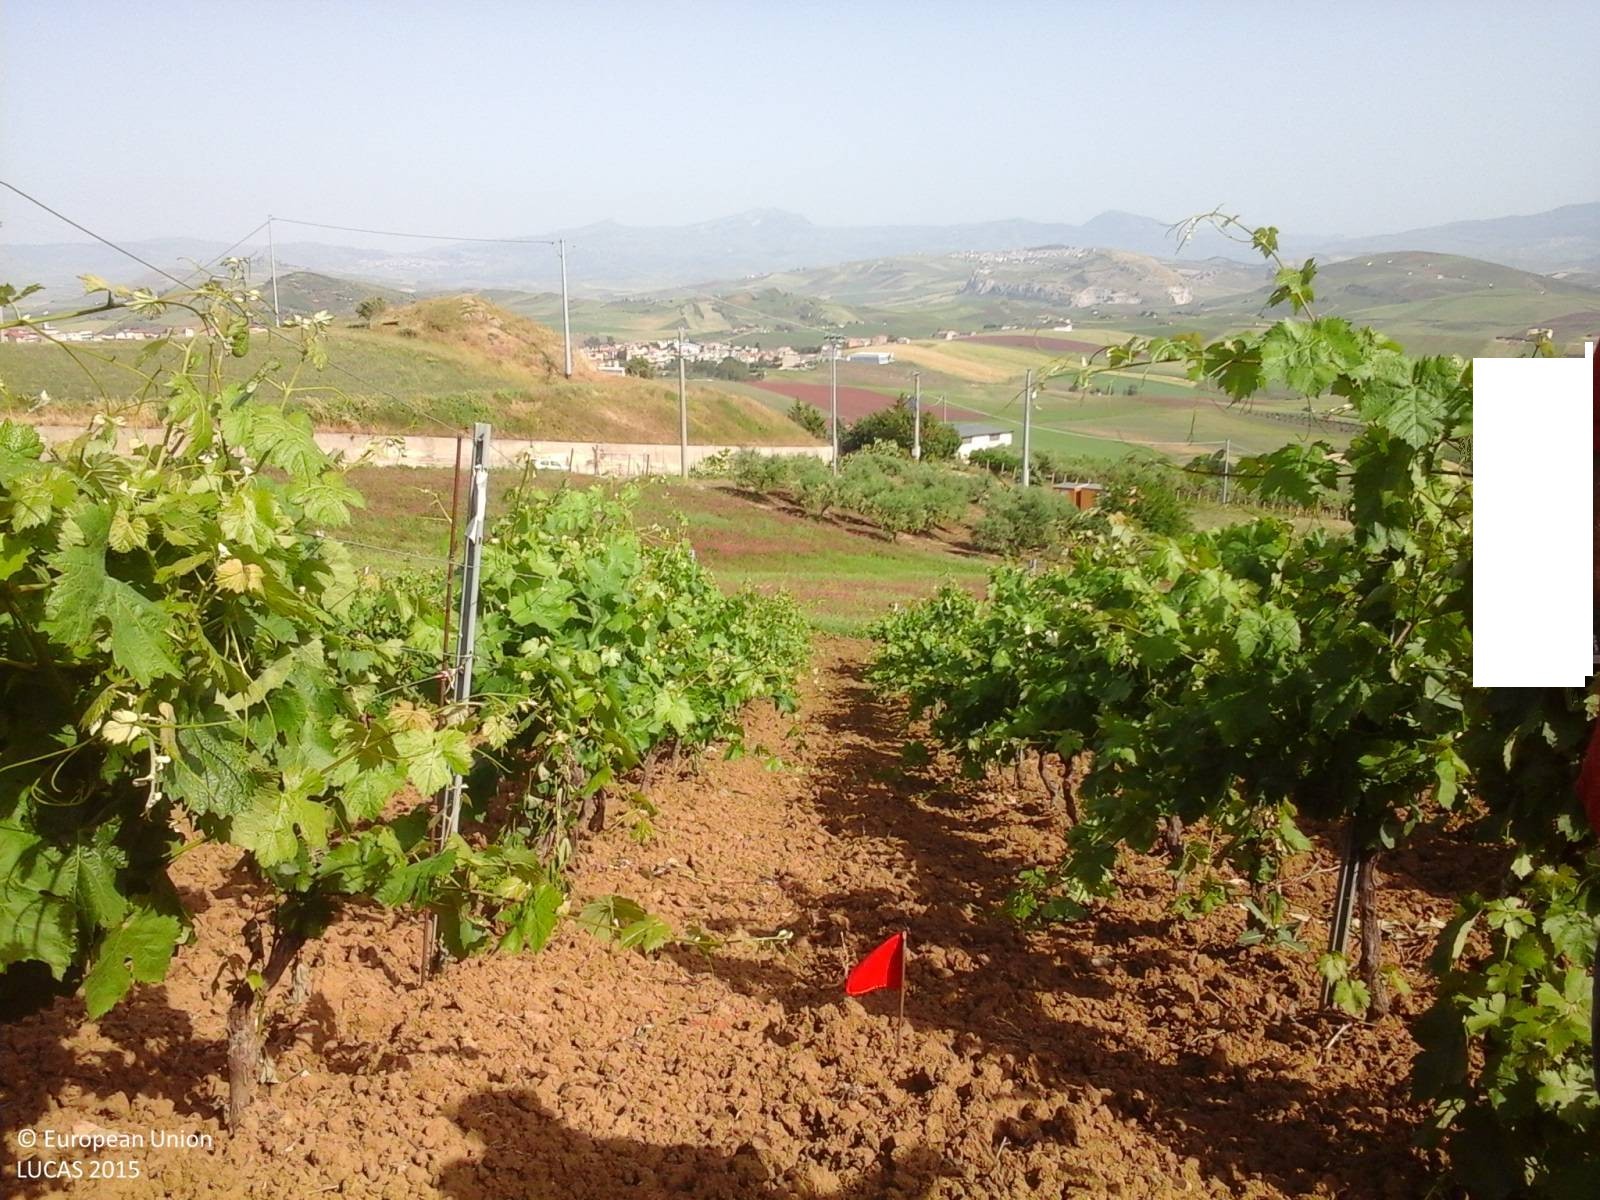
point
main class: Cropland
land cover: Vineyards
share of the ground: 50 - 75 %
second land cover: Other bare soil
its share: > 75 %
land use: Agriculture (excluding fallow land and kitchen gardens)
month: May
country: IT
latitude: 37.8974
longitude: 13.0822
